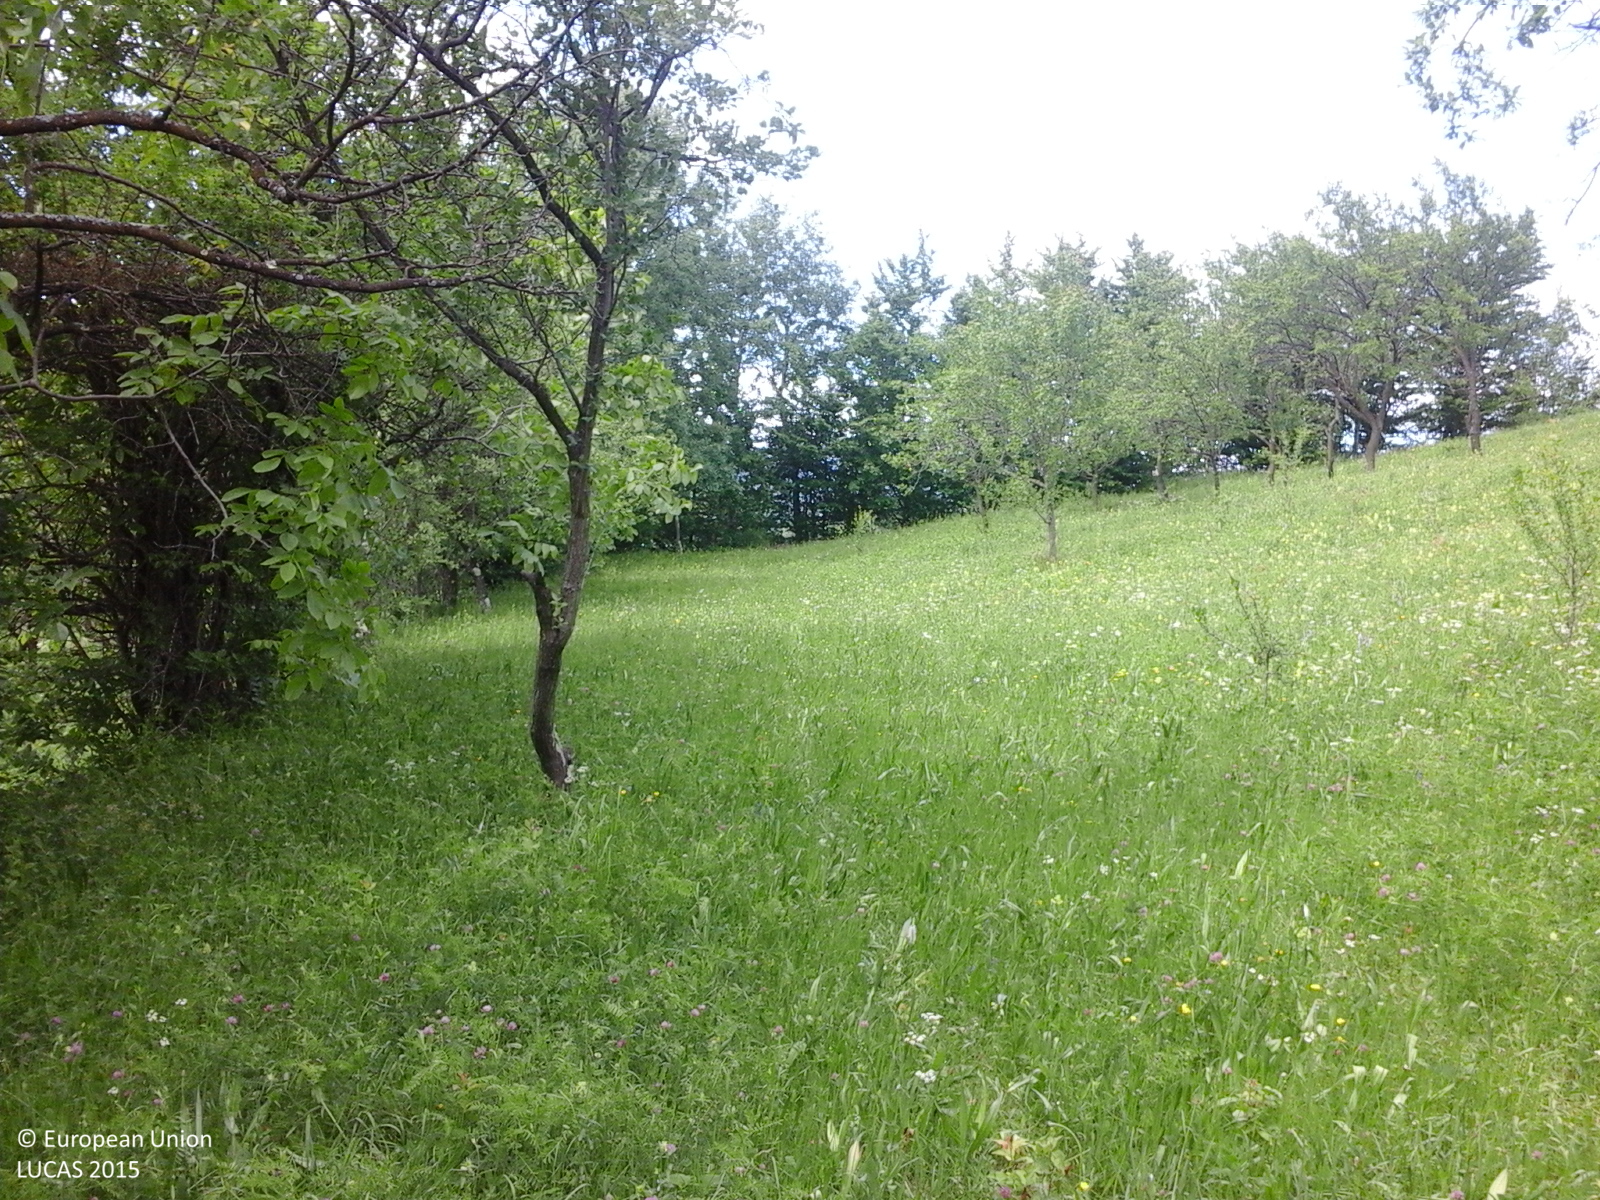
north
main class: Cropland
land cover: Other fruit trees and berries
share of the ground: 25 - 50 %
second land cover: Grassland without tree/shrub cover
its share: > 75 %
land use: Agriculture (excluding fallow land and kitchen gardens)
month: May
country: RO
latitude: 45.3136
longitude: 26.0440
